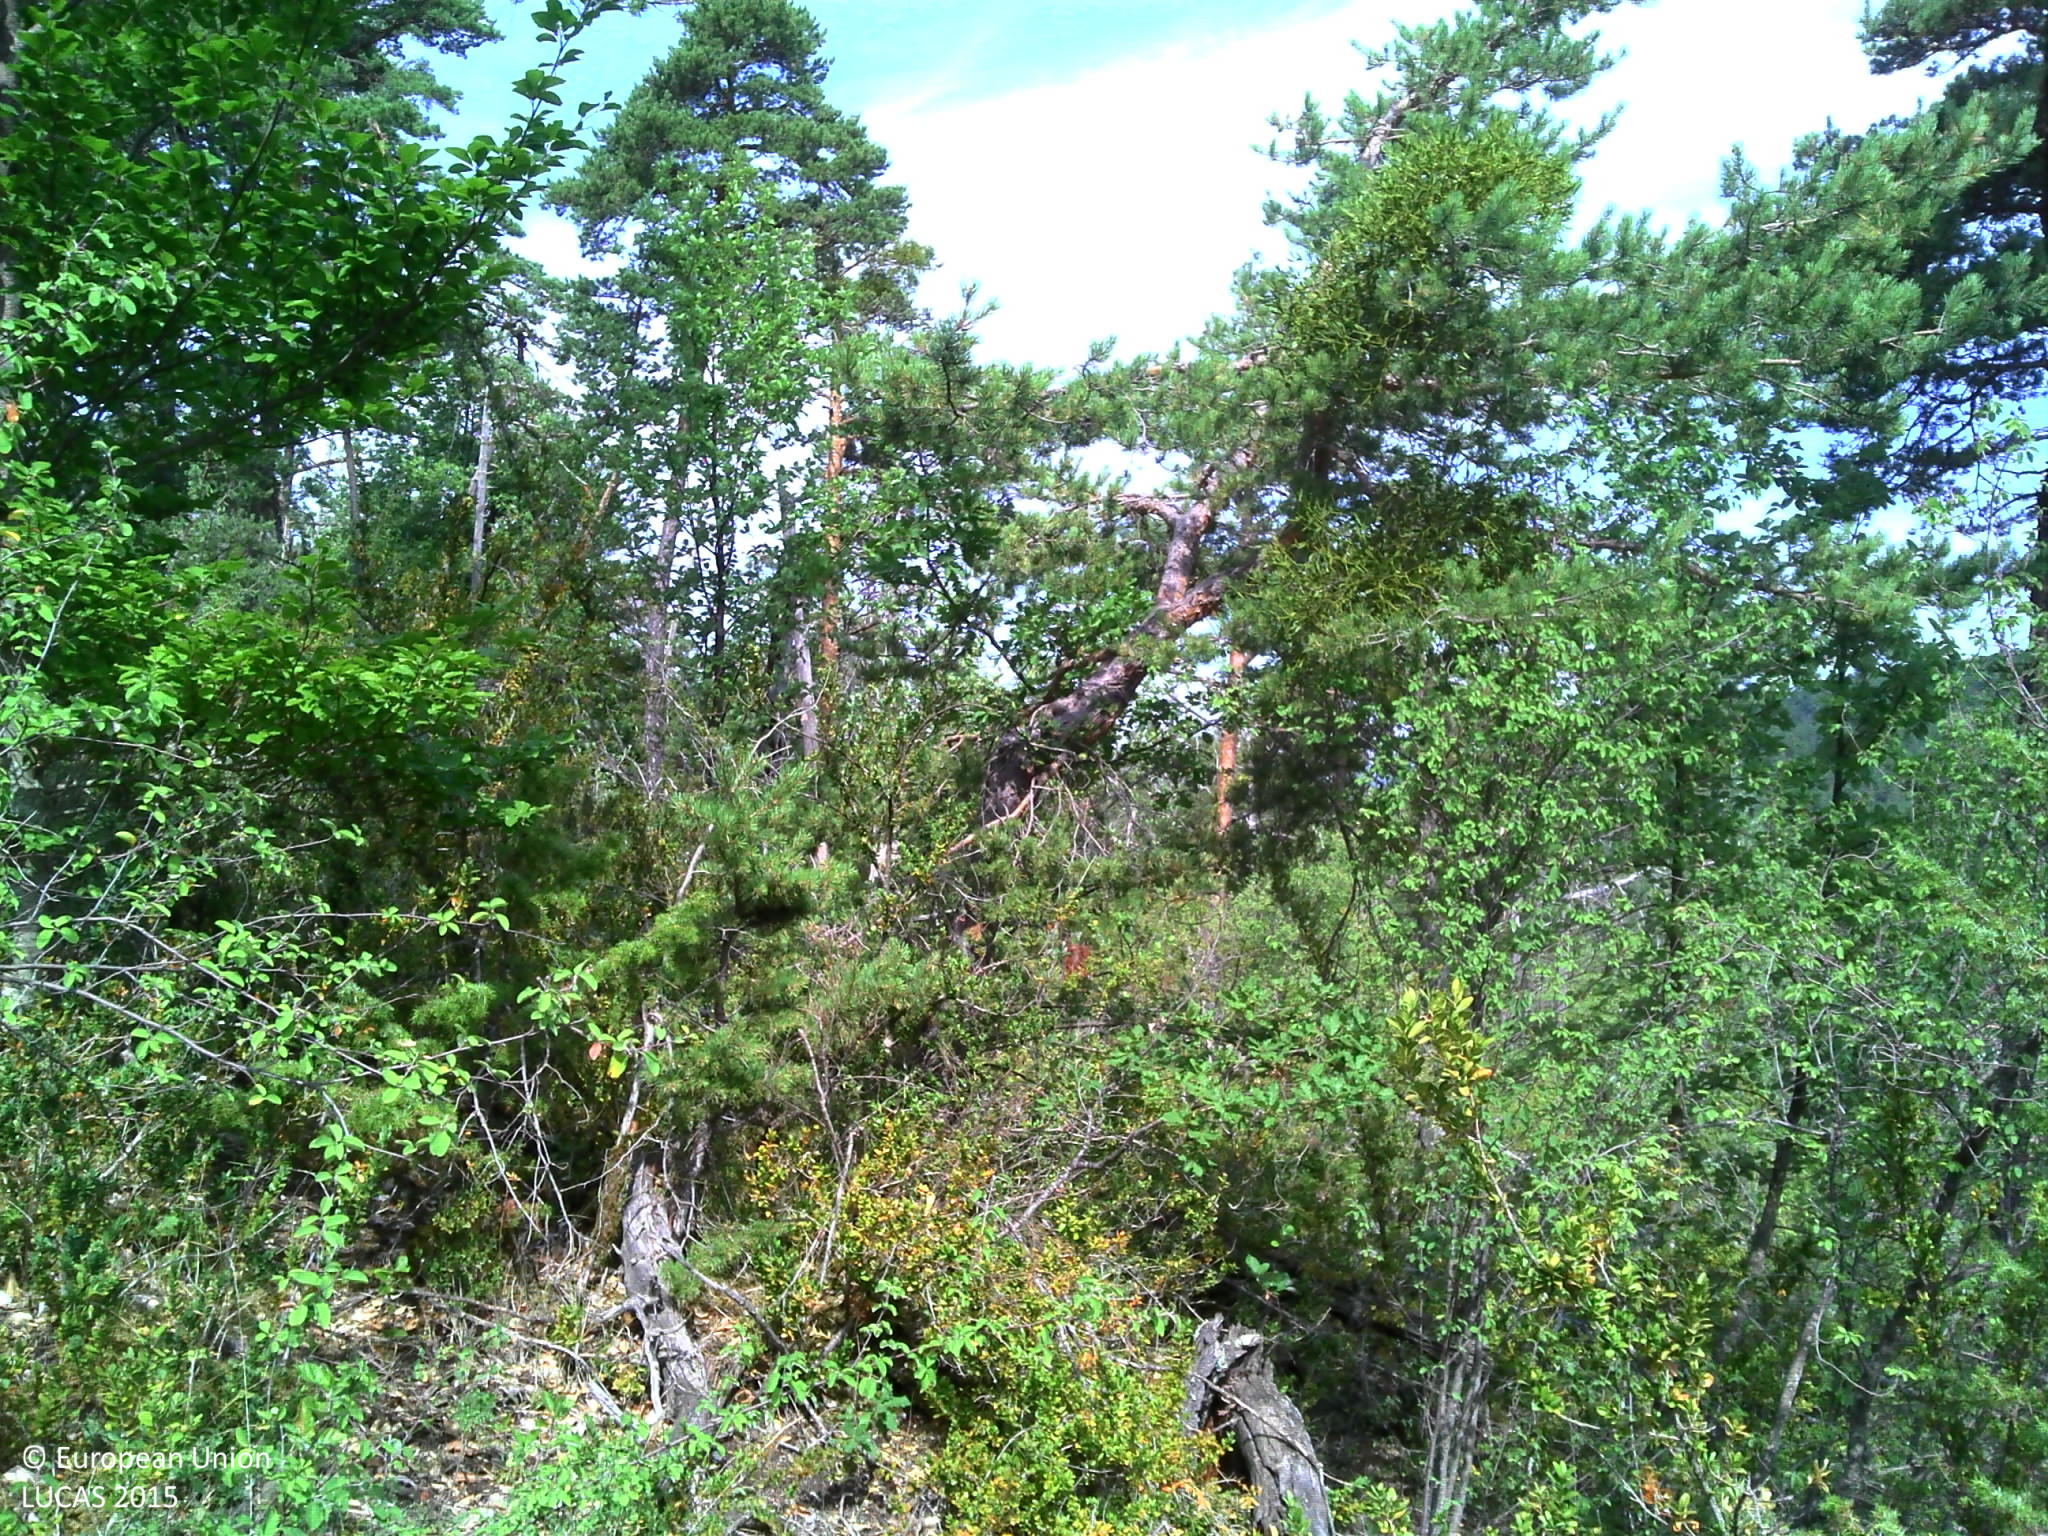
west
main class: Woodland
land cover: Pine dominated mixed woodland
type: coniferous forest of the mediterranean region
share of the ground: 50 - 75 %
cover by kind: coniferous forest trees 40 %, broadleaved forest trees 20 %, herbaceous plants 20 %, shrubs 10 %, lichens and mosses 10 %
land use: Forestry
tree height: > 5 m
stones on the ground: 25 - 50 %
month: July
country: FR
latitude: 43.7977
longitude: 6.3168
